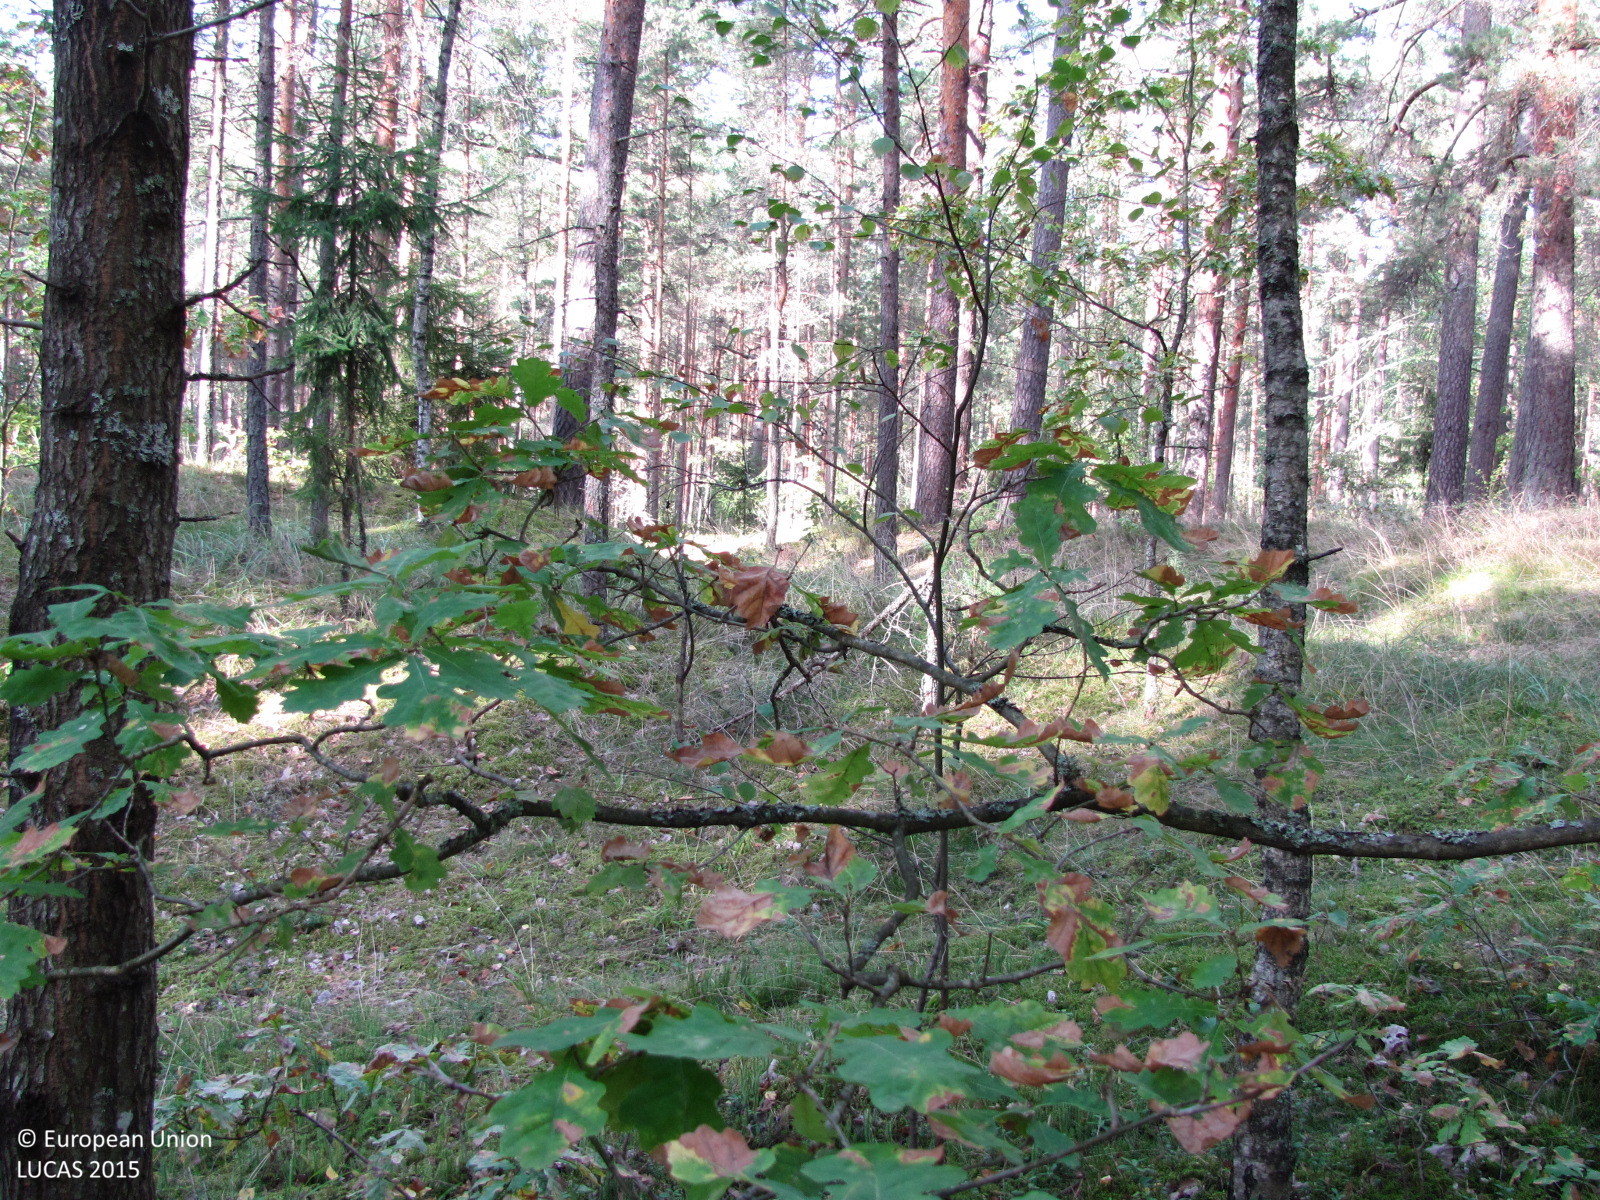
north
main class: Woodland
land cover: Pine dominated mixed woodland
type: hemiboreal forest and nemoral coniferous forest and mixed broadleaved-coniferous forest
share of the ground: > 75 %
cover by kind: coniferous forest trees 60 %, broadleaved forest trees 25 %, herbaceous plants 10 %, lichens and mosses 5 %
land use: Forestry
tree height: > 5 m
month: September
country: LV
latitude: 57.0692
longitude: 24.4243
